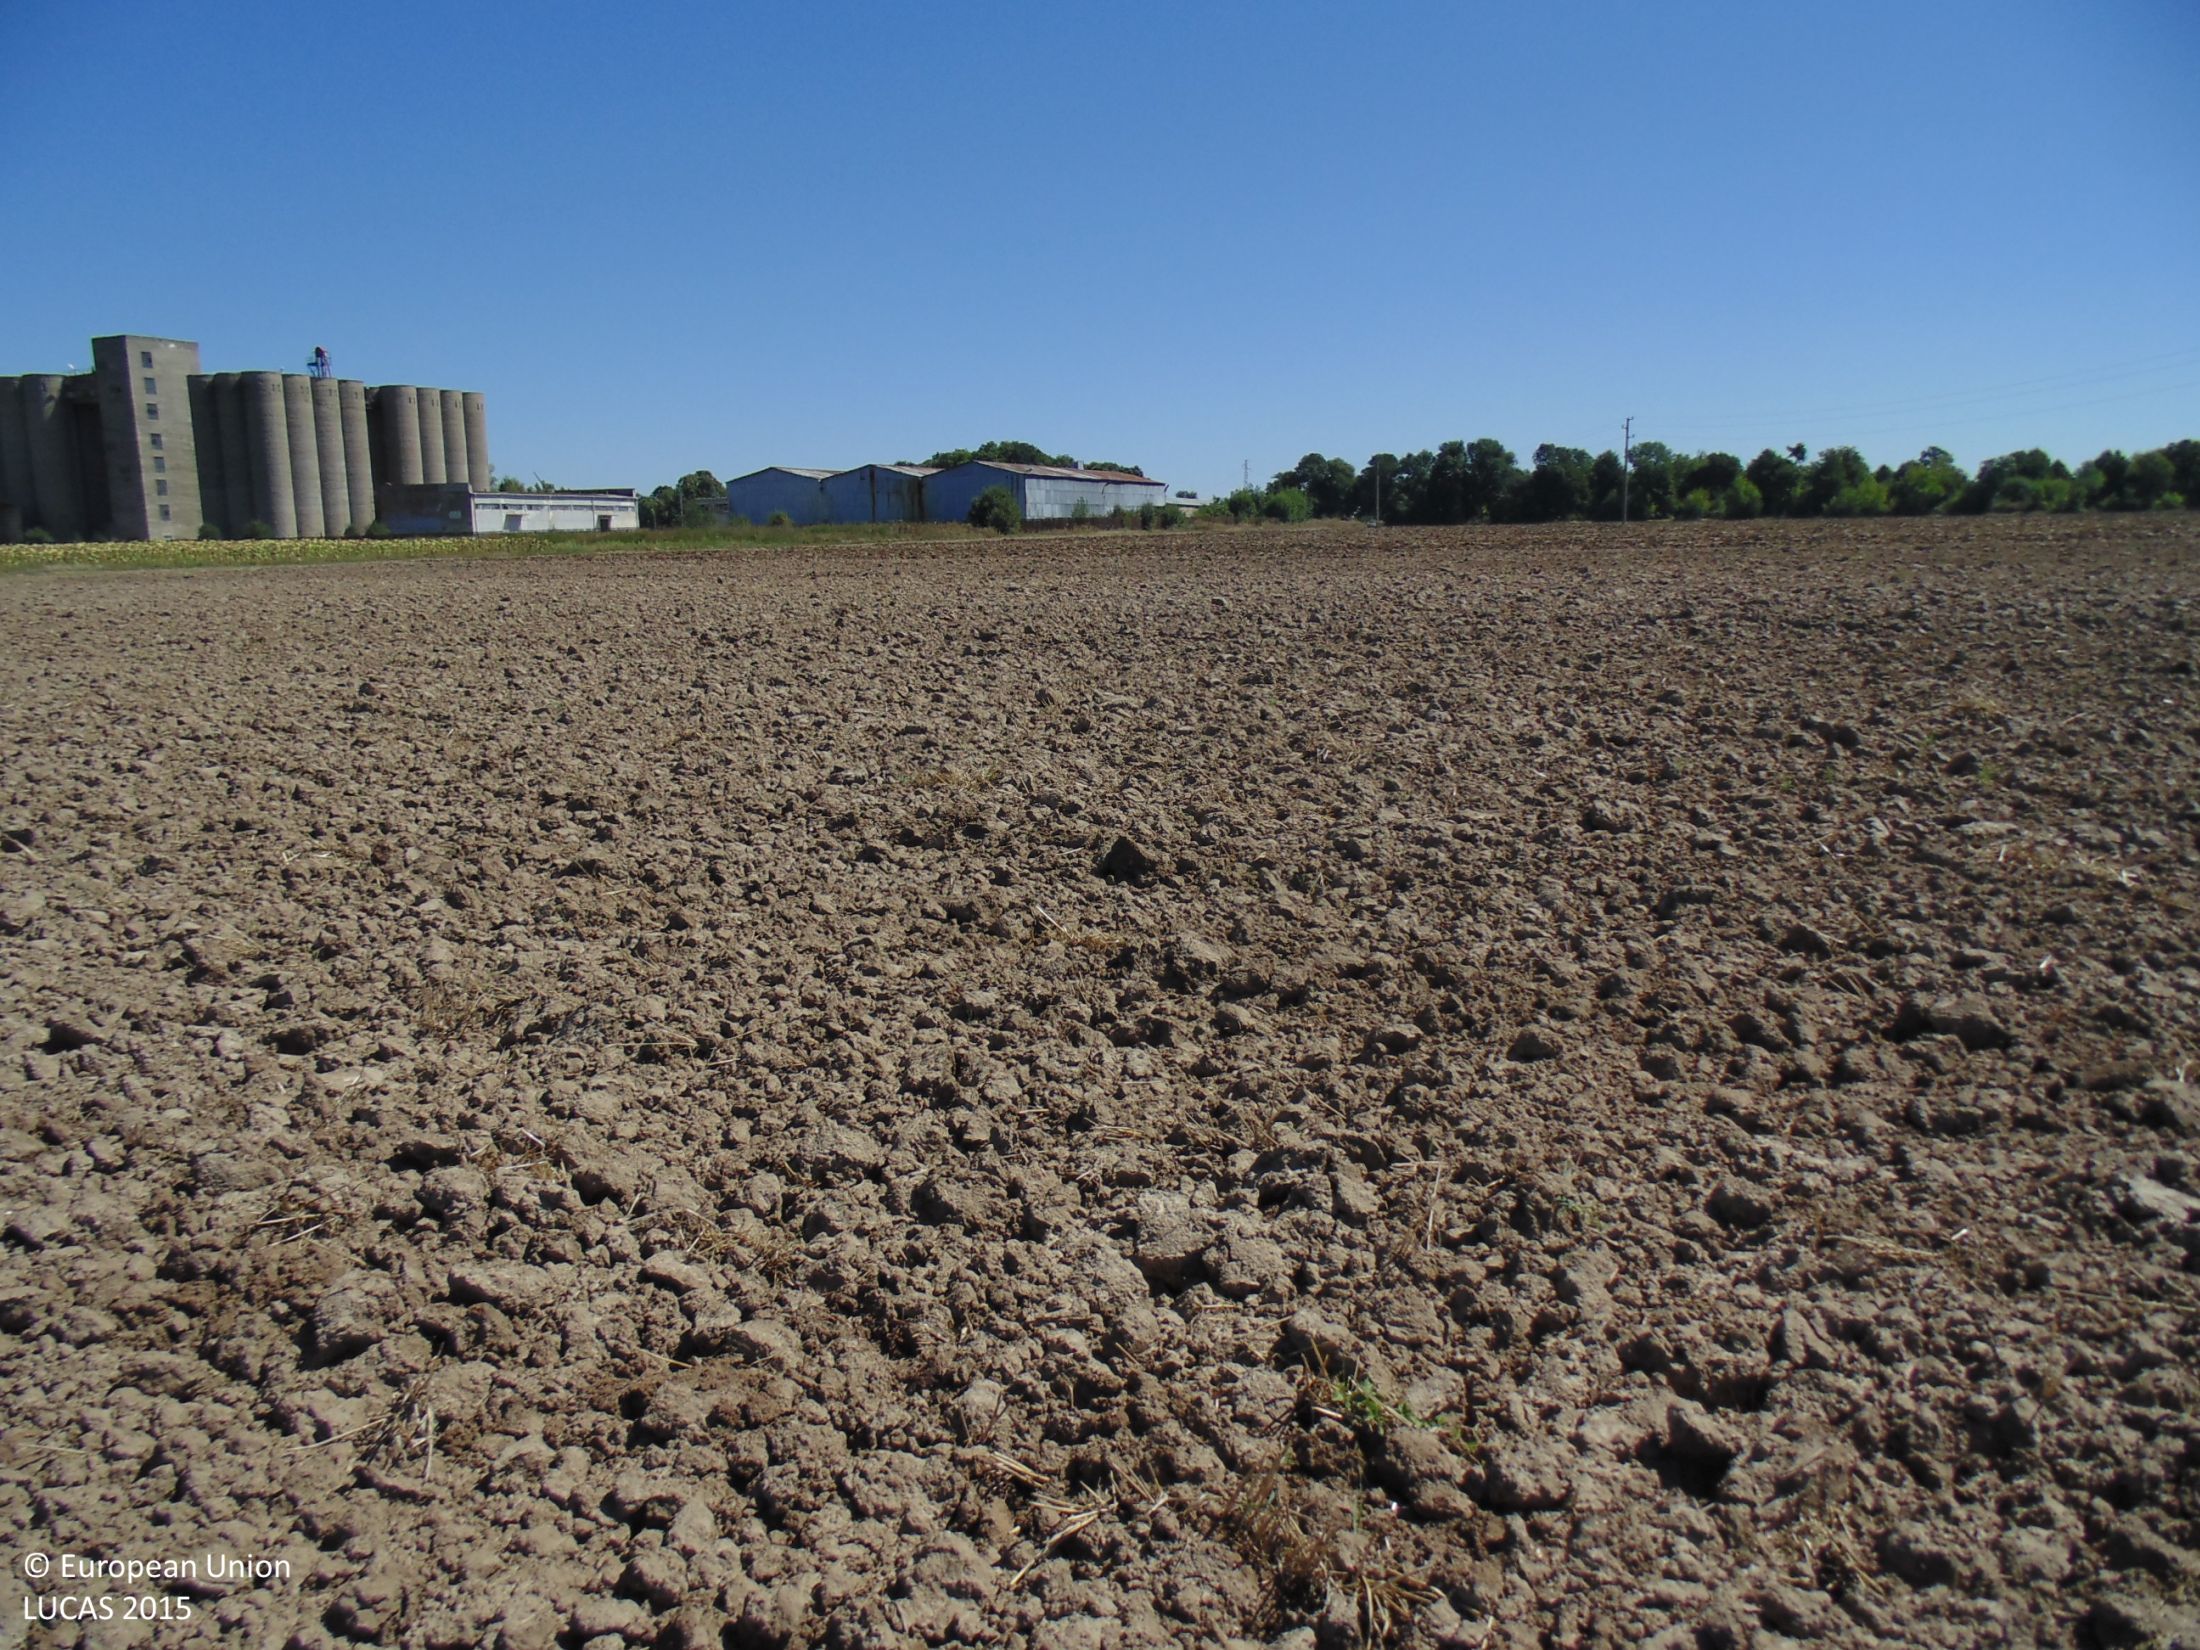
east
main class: Cropland
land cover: Common wheat
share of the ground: < 10 %
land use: Agriculture (excluding fallow land and kitchen gardens)
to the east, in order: Common wheat; Grass margins; Tracks; Grass margins; Spontaneously vegetated surfaces; Artificial constructions in urban areas
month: September
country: BG
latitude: 43.7952
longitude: 27.1389
